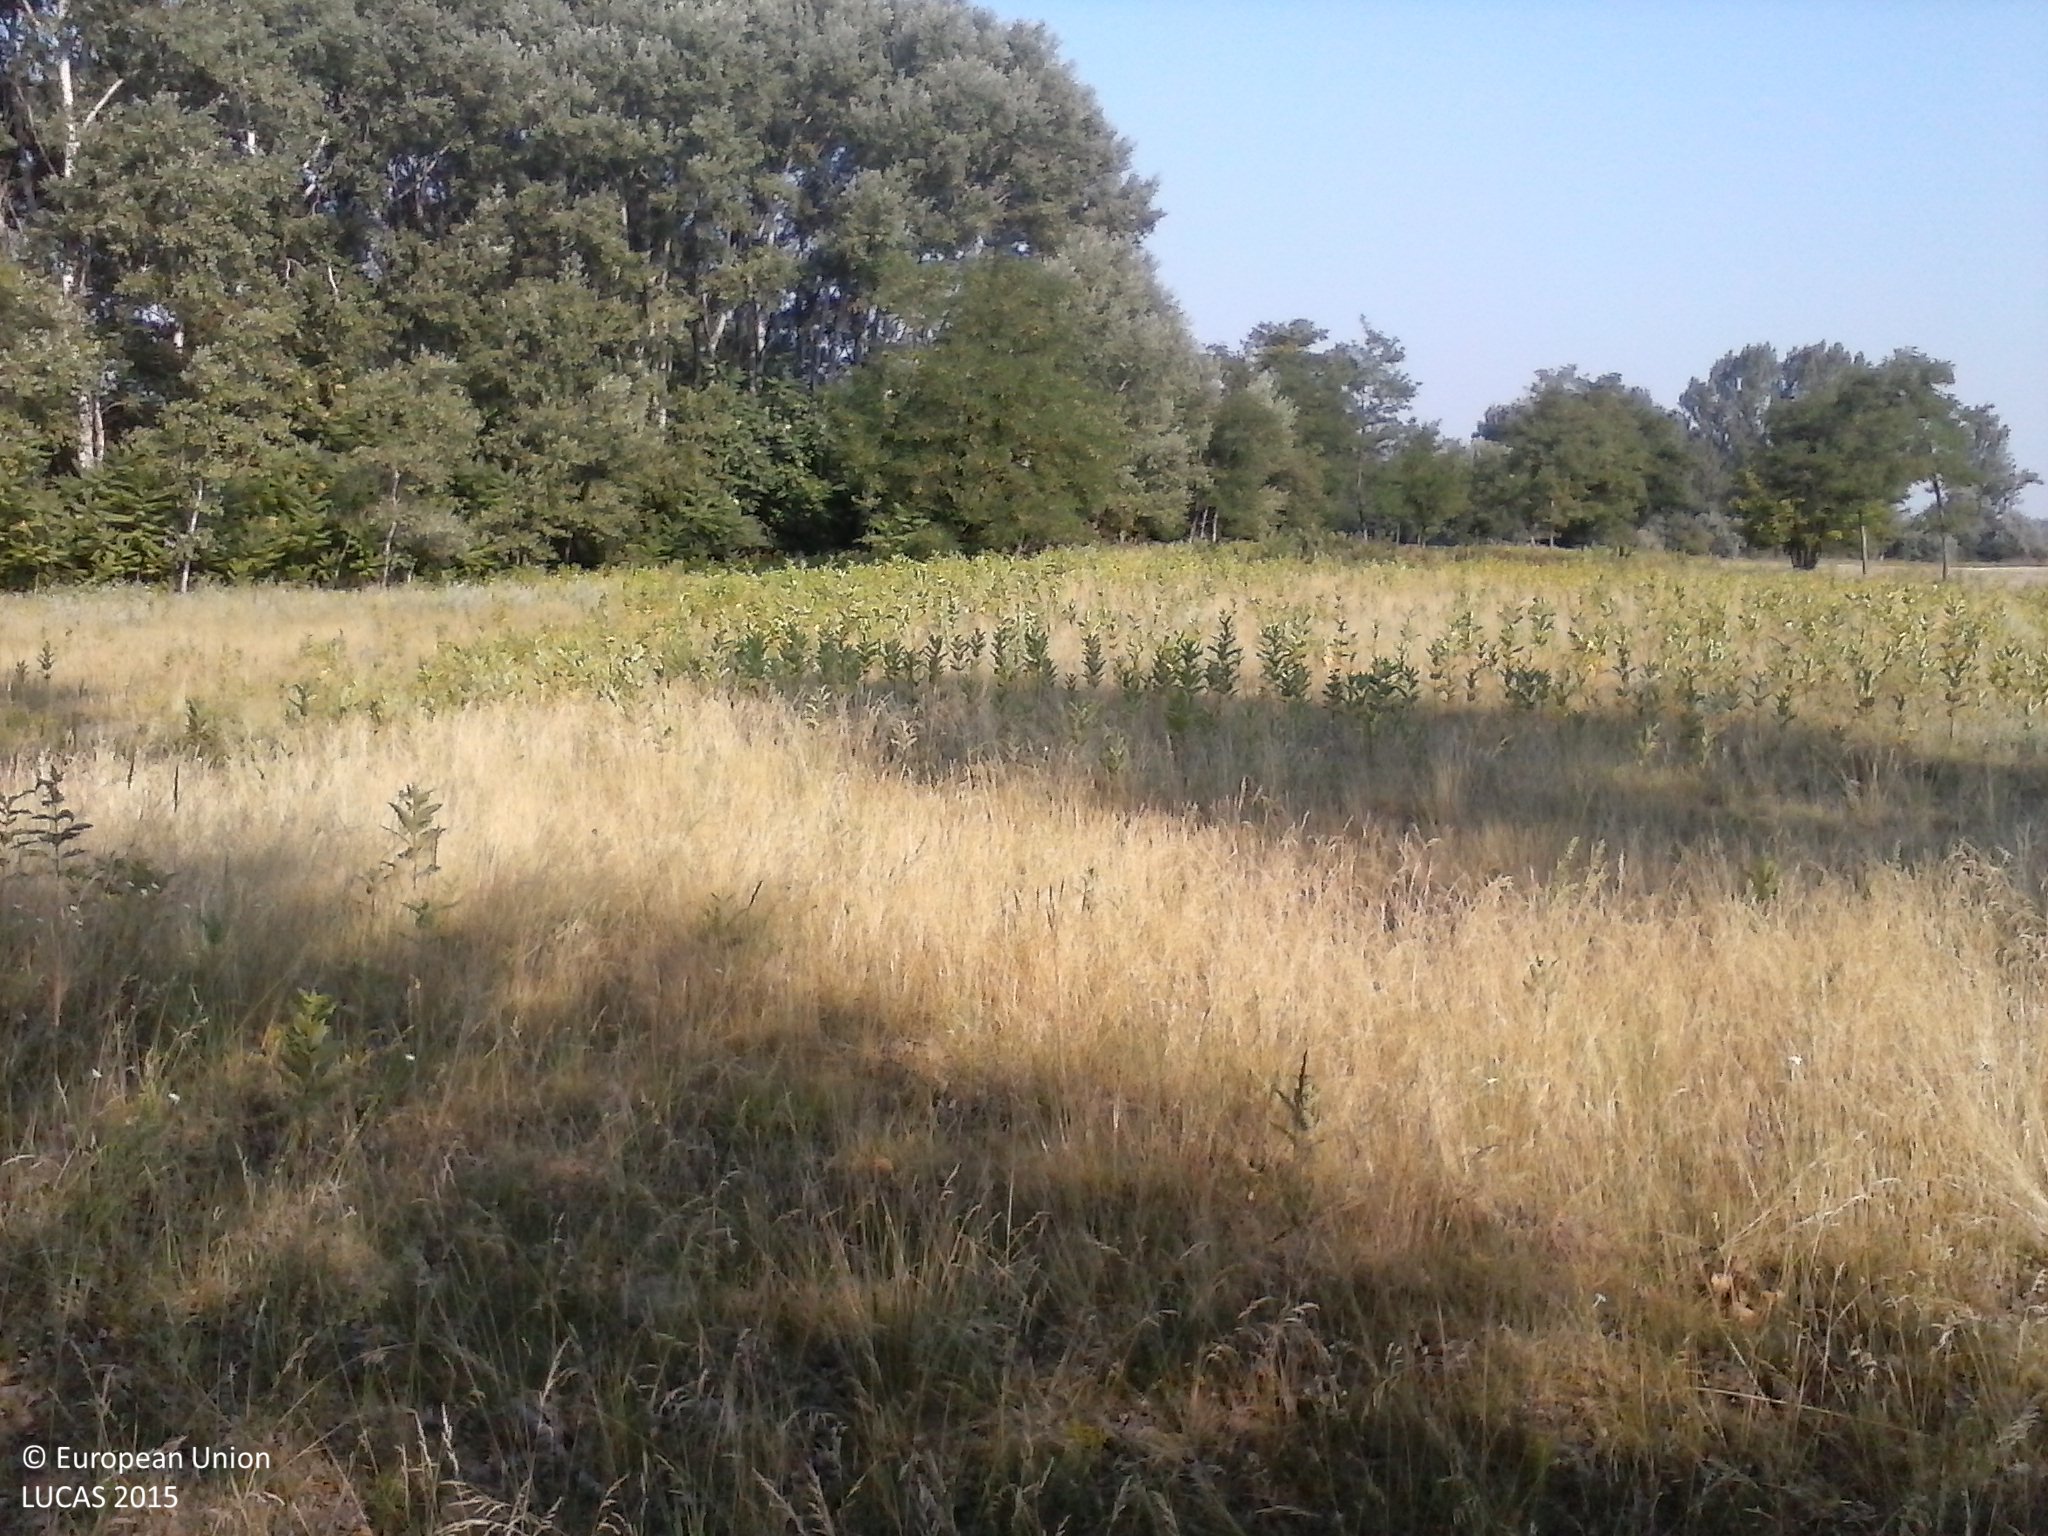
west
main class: Woodland
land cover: Broadleaved woodland
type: mesophytic deciduous forest
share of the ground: 25 - 50 %
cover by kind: herbaceous plants 70 %, broadleaved forest trees 25 %, shrubs 5 %
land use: Forestry
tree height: > 5 m
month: July
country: HU
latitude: 46.4006
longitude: 19.6824
